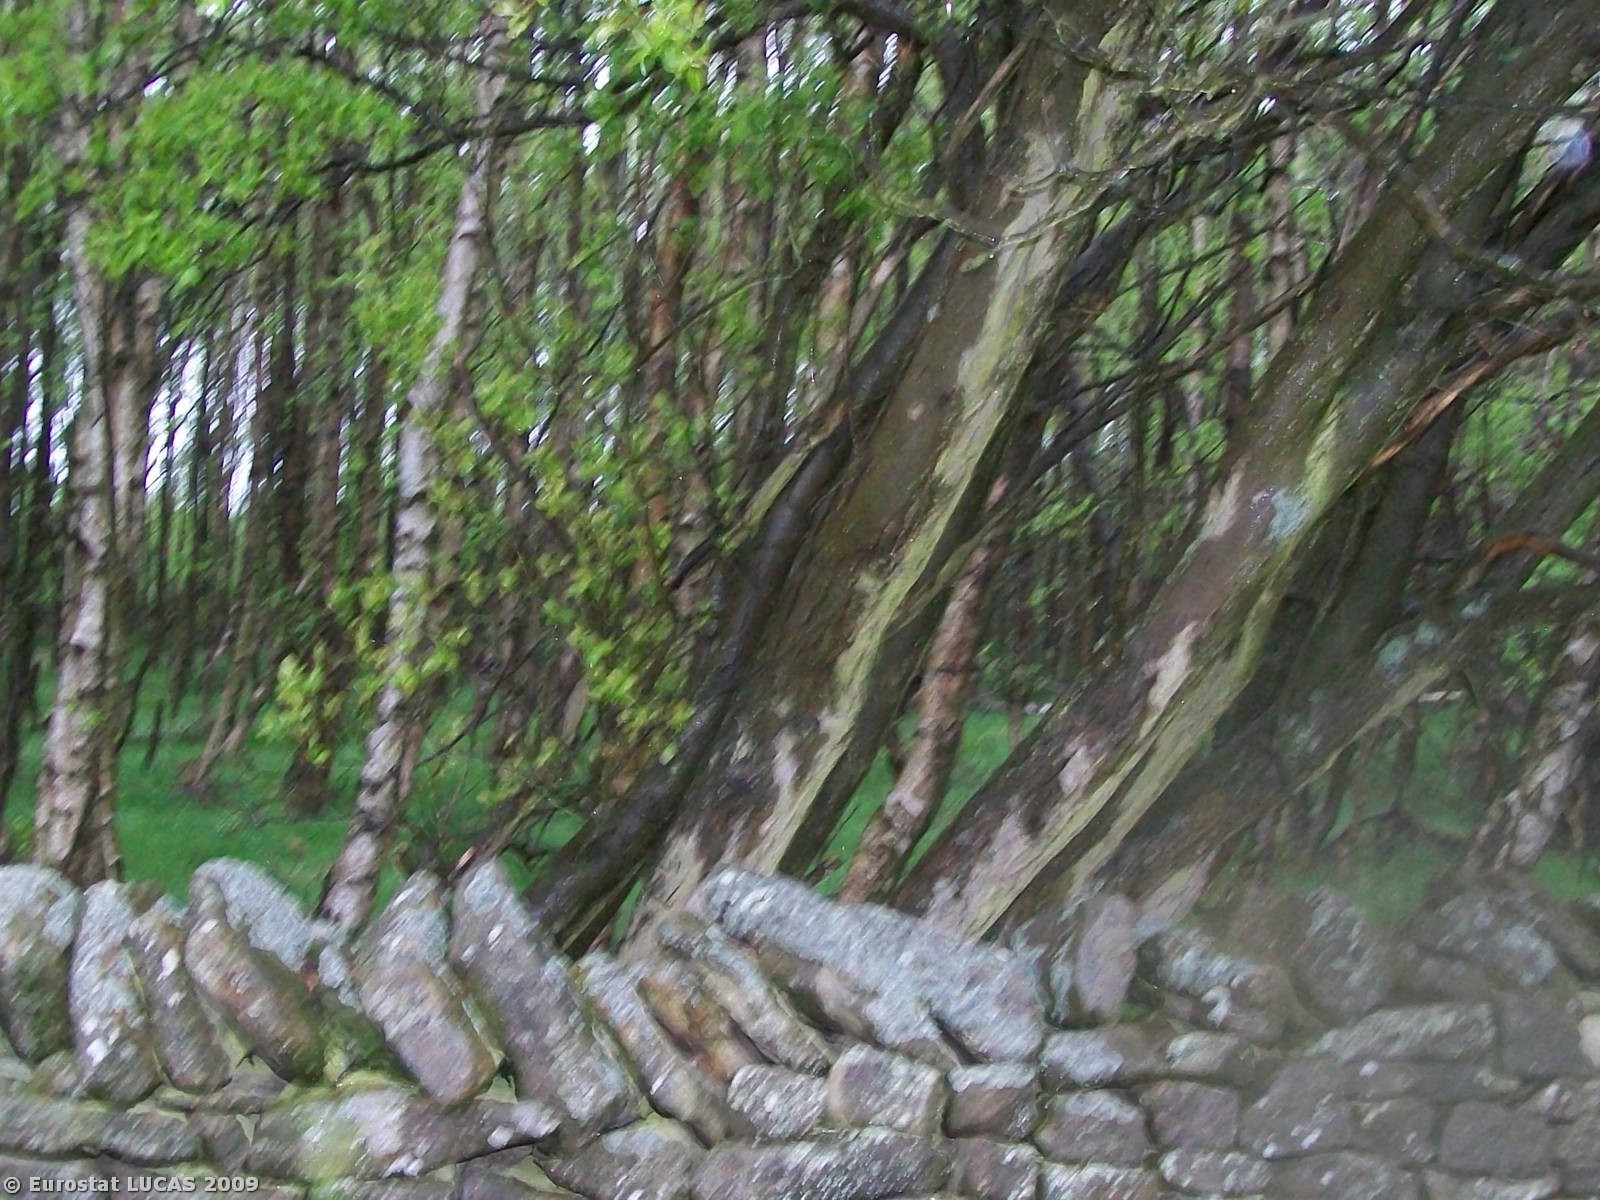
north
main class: Woodland
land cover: Broadleaved woodland
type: mesophytic deciduous forest
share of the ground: > 75 %
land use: Unused
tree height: > 5 m
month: May
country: GB
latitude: 54.8960
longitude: -1.9829
